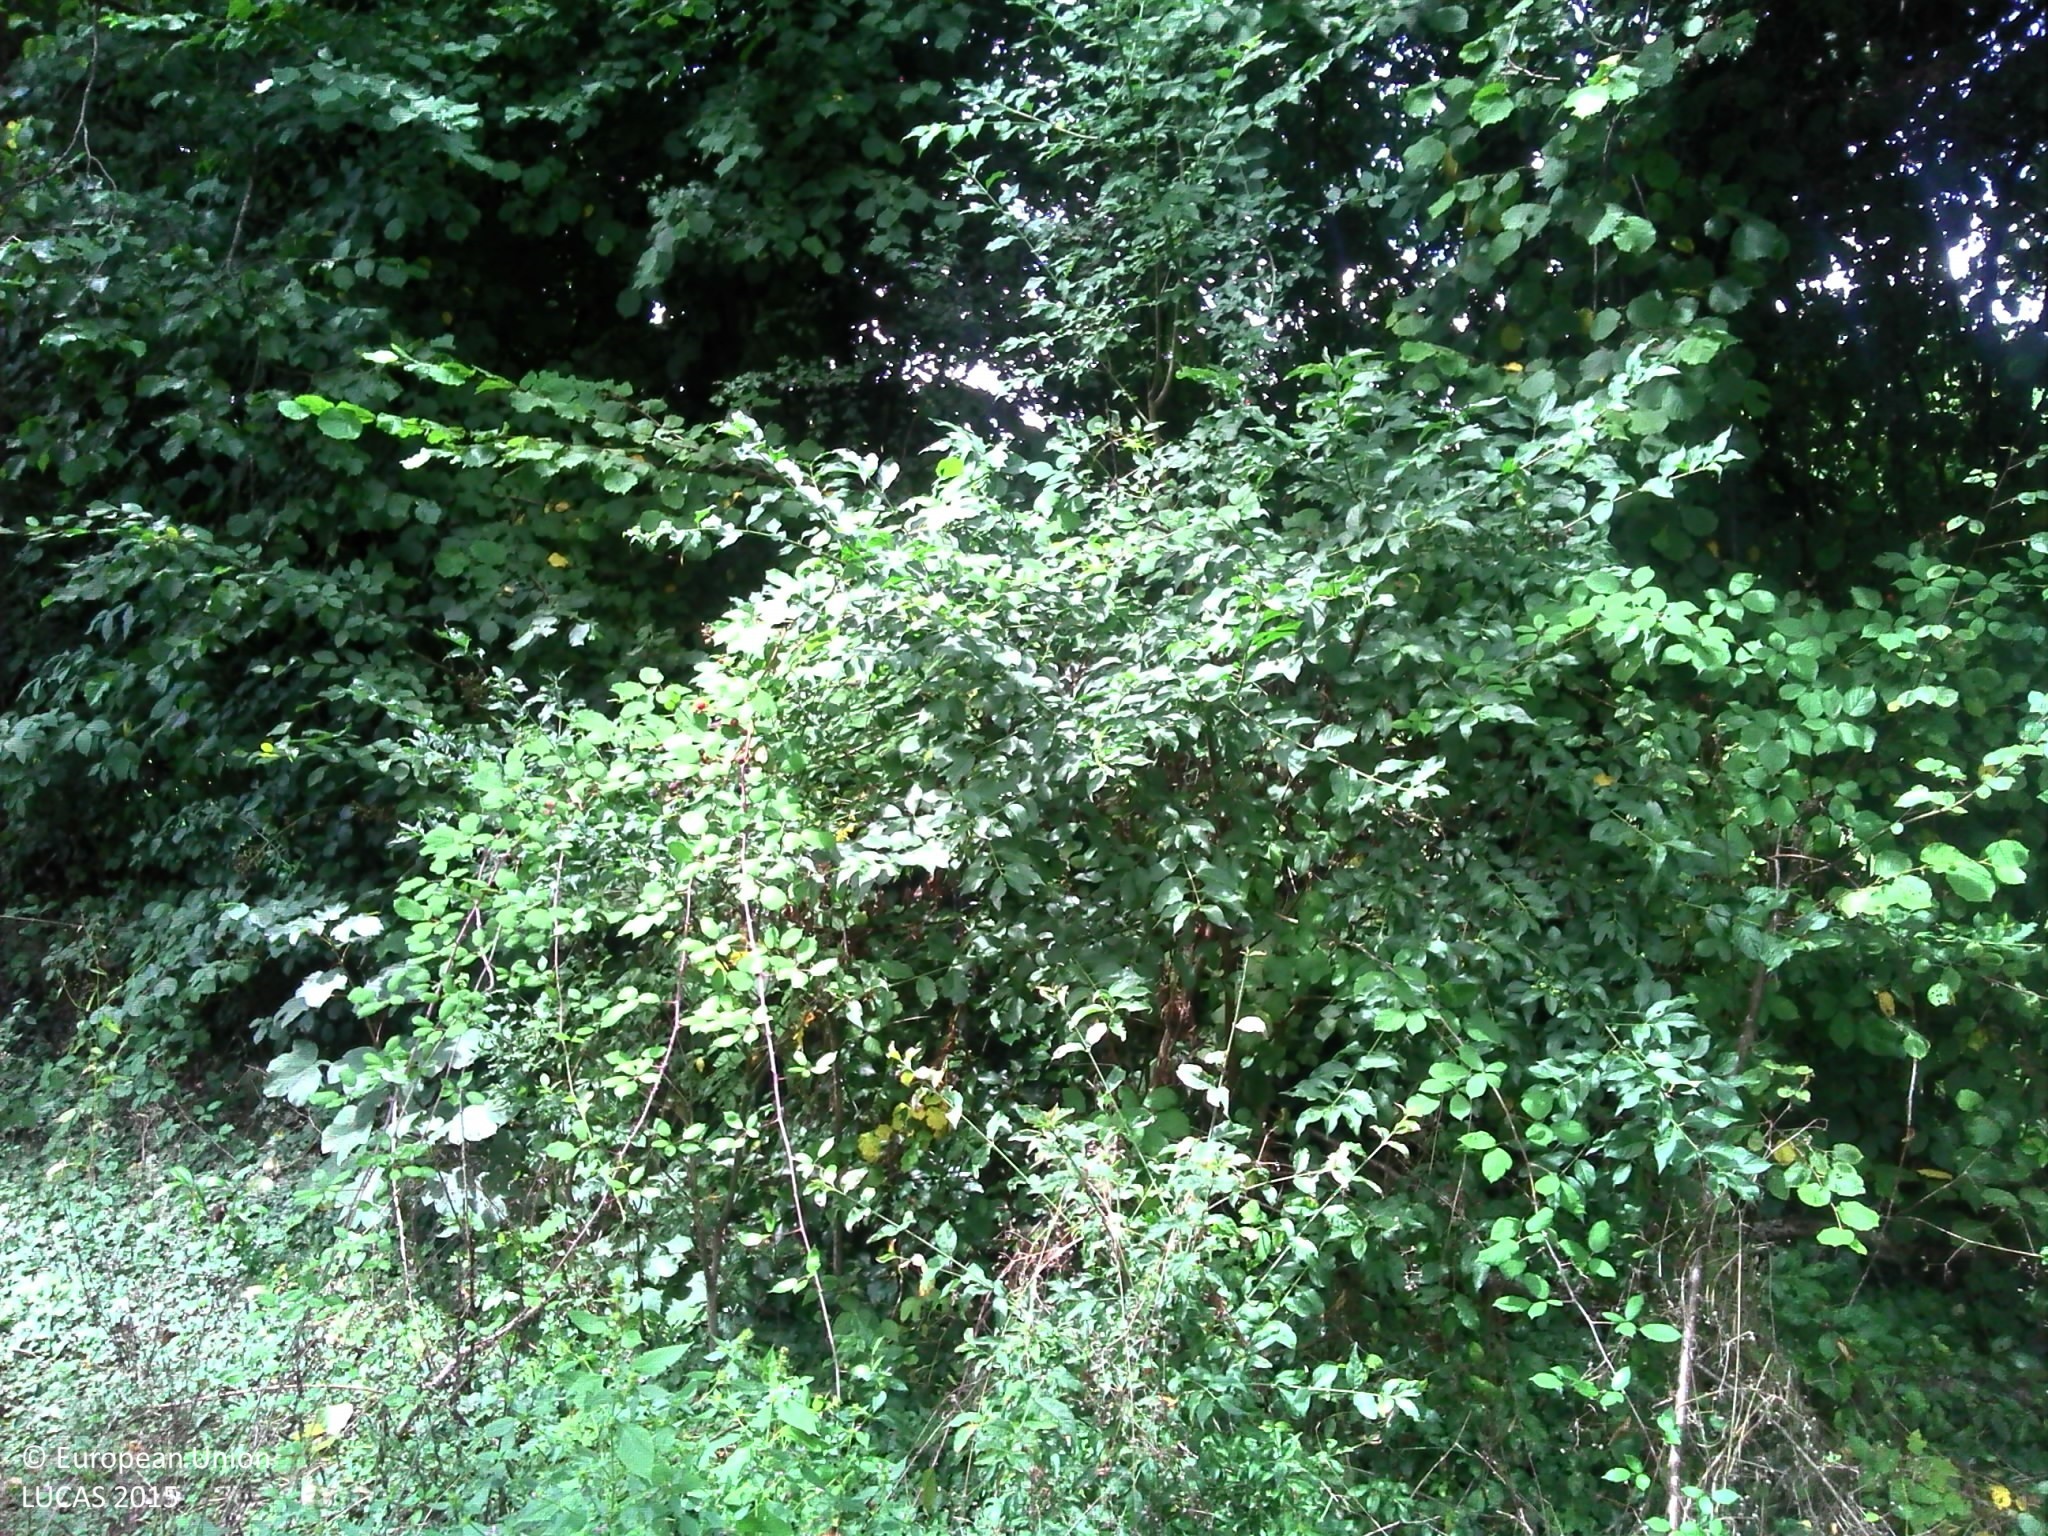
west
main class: Grassland
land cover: Grassland without tree/shrub cover
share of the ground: > 75 %
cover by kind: herbaceous plants 100 %
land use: Agriculture (excluding fallow land and kitchen gardens)
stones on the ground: < 10 %
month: August
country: FR
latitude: 45.2442
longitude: 5.4570
